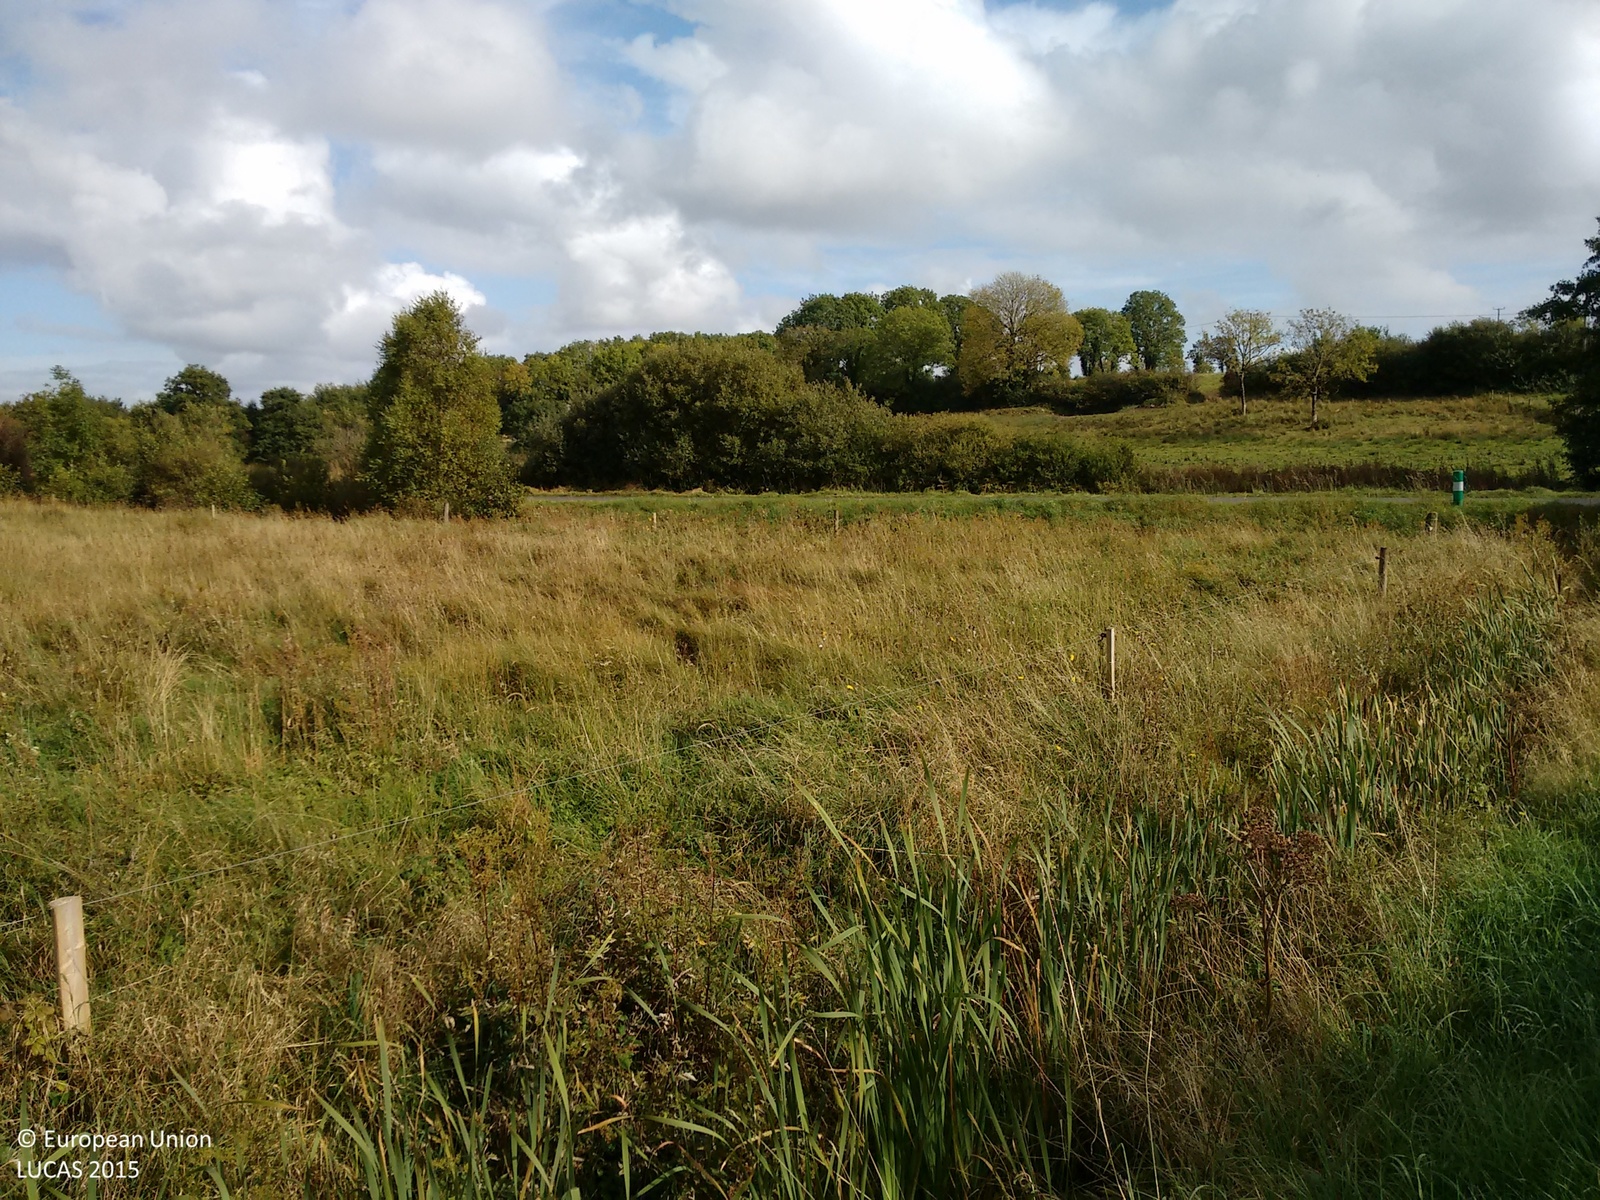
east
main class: Grassland
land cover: Grassland without tree/shrub cover
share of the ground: > 75 %
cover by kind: herbaceous plants 100 %
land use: Agriculture (excluding fallow land and kitchen gardens)
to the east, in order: Grassland without tree/shrub cover; Fences; Ditches and canals; Grass margins; Paved roads, cycling and walking lanes; Grass margins; Broadleaved woodland; Ditches and canals; Broadleaved woodland; Fences; Grassland without tree/shrub cover; Broadleaved woodland; Grassland without tree/shrub cover; Electric lines; Grassland without tree/shrub cover; Broadleaved woodland; Grassland without tree/shrub cover
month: October
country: IE
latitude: 53.8358
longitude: -8.0623
